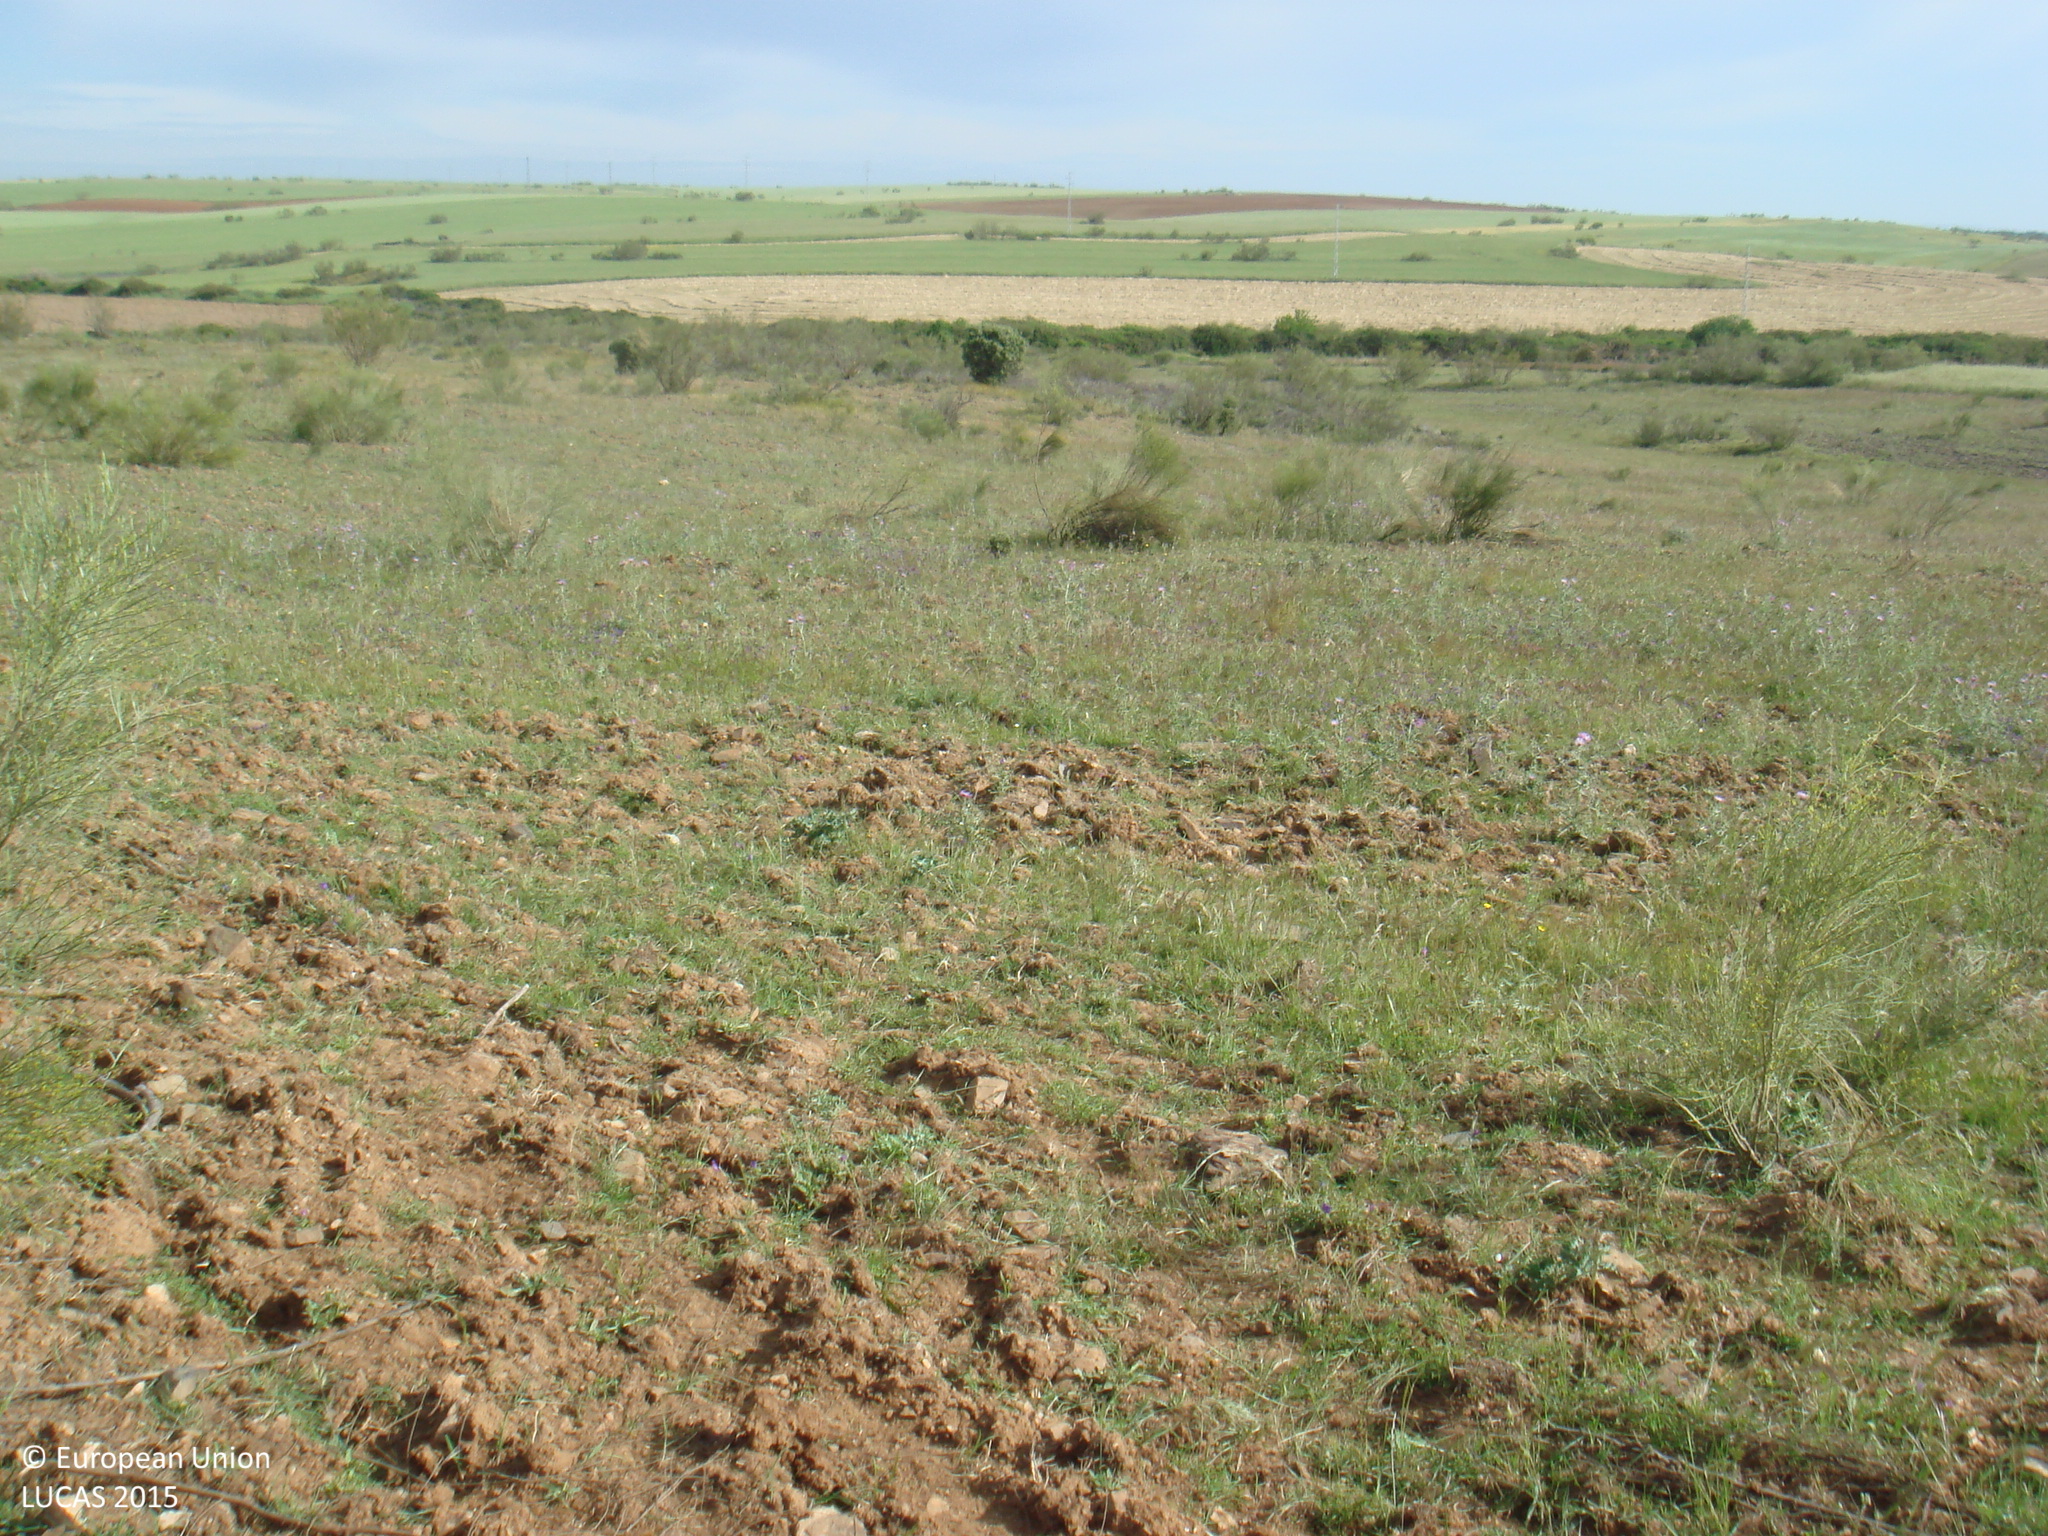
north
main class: Shrubland
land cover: Shrubland without tree cover
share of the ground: > 75 %
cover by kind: herbaceous plants 70 %, shrubs 30 %
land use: Semi-natural and natural areas not in use
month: May
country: ES
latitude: 38.4307
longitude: -5.0917
